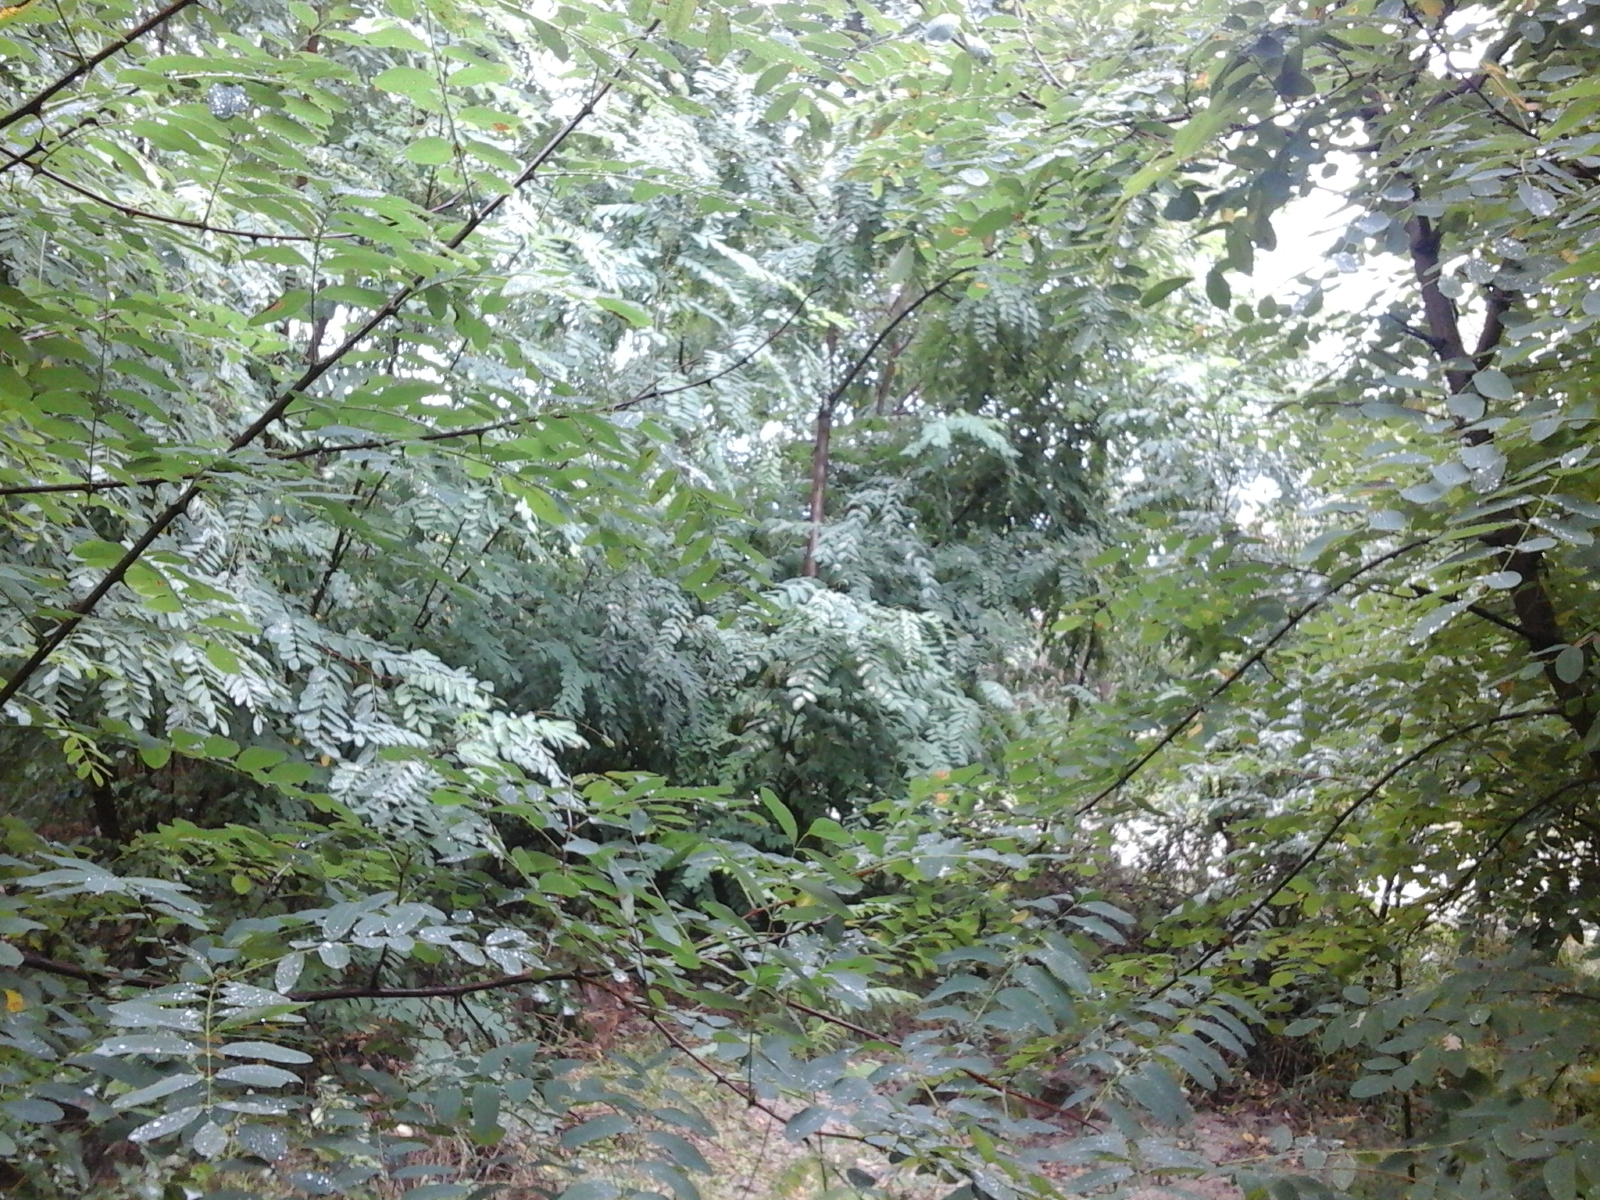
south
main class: Woodland
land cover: Broadleaved woodland
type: exotic forest
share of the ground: > 75 %
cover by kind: broadleaved forest trees 100 %
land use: Forestry
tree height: > 5 m
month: September
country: RO
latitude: 45.0192
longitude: 23.7544
